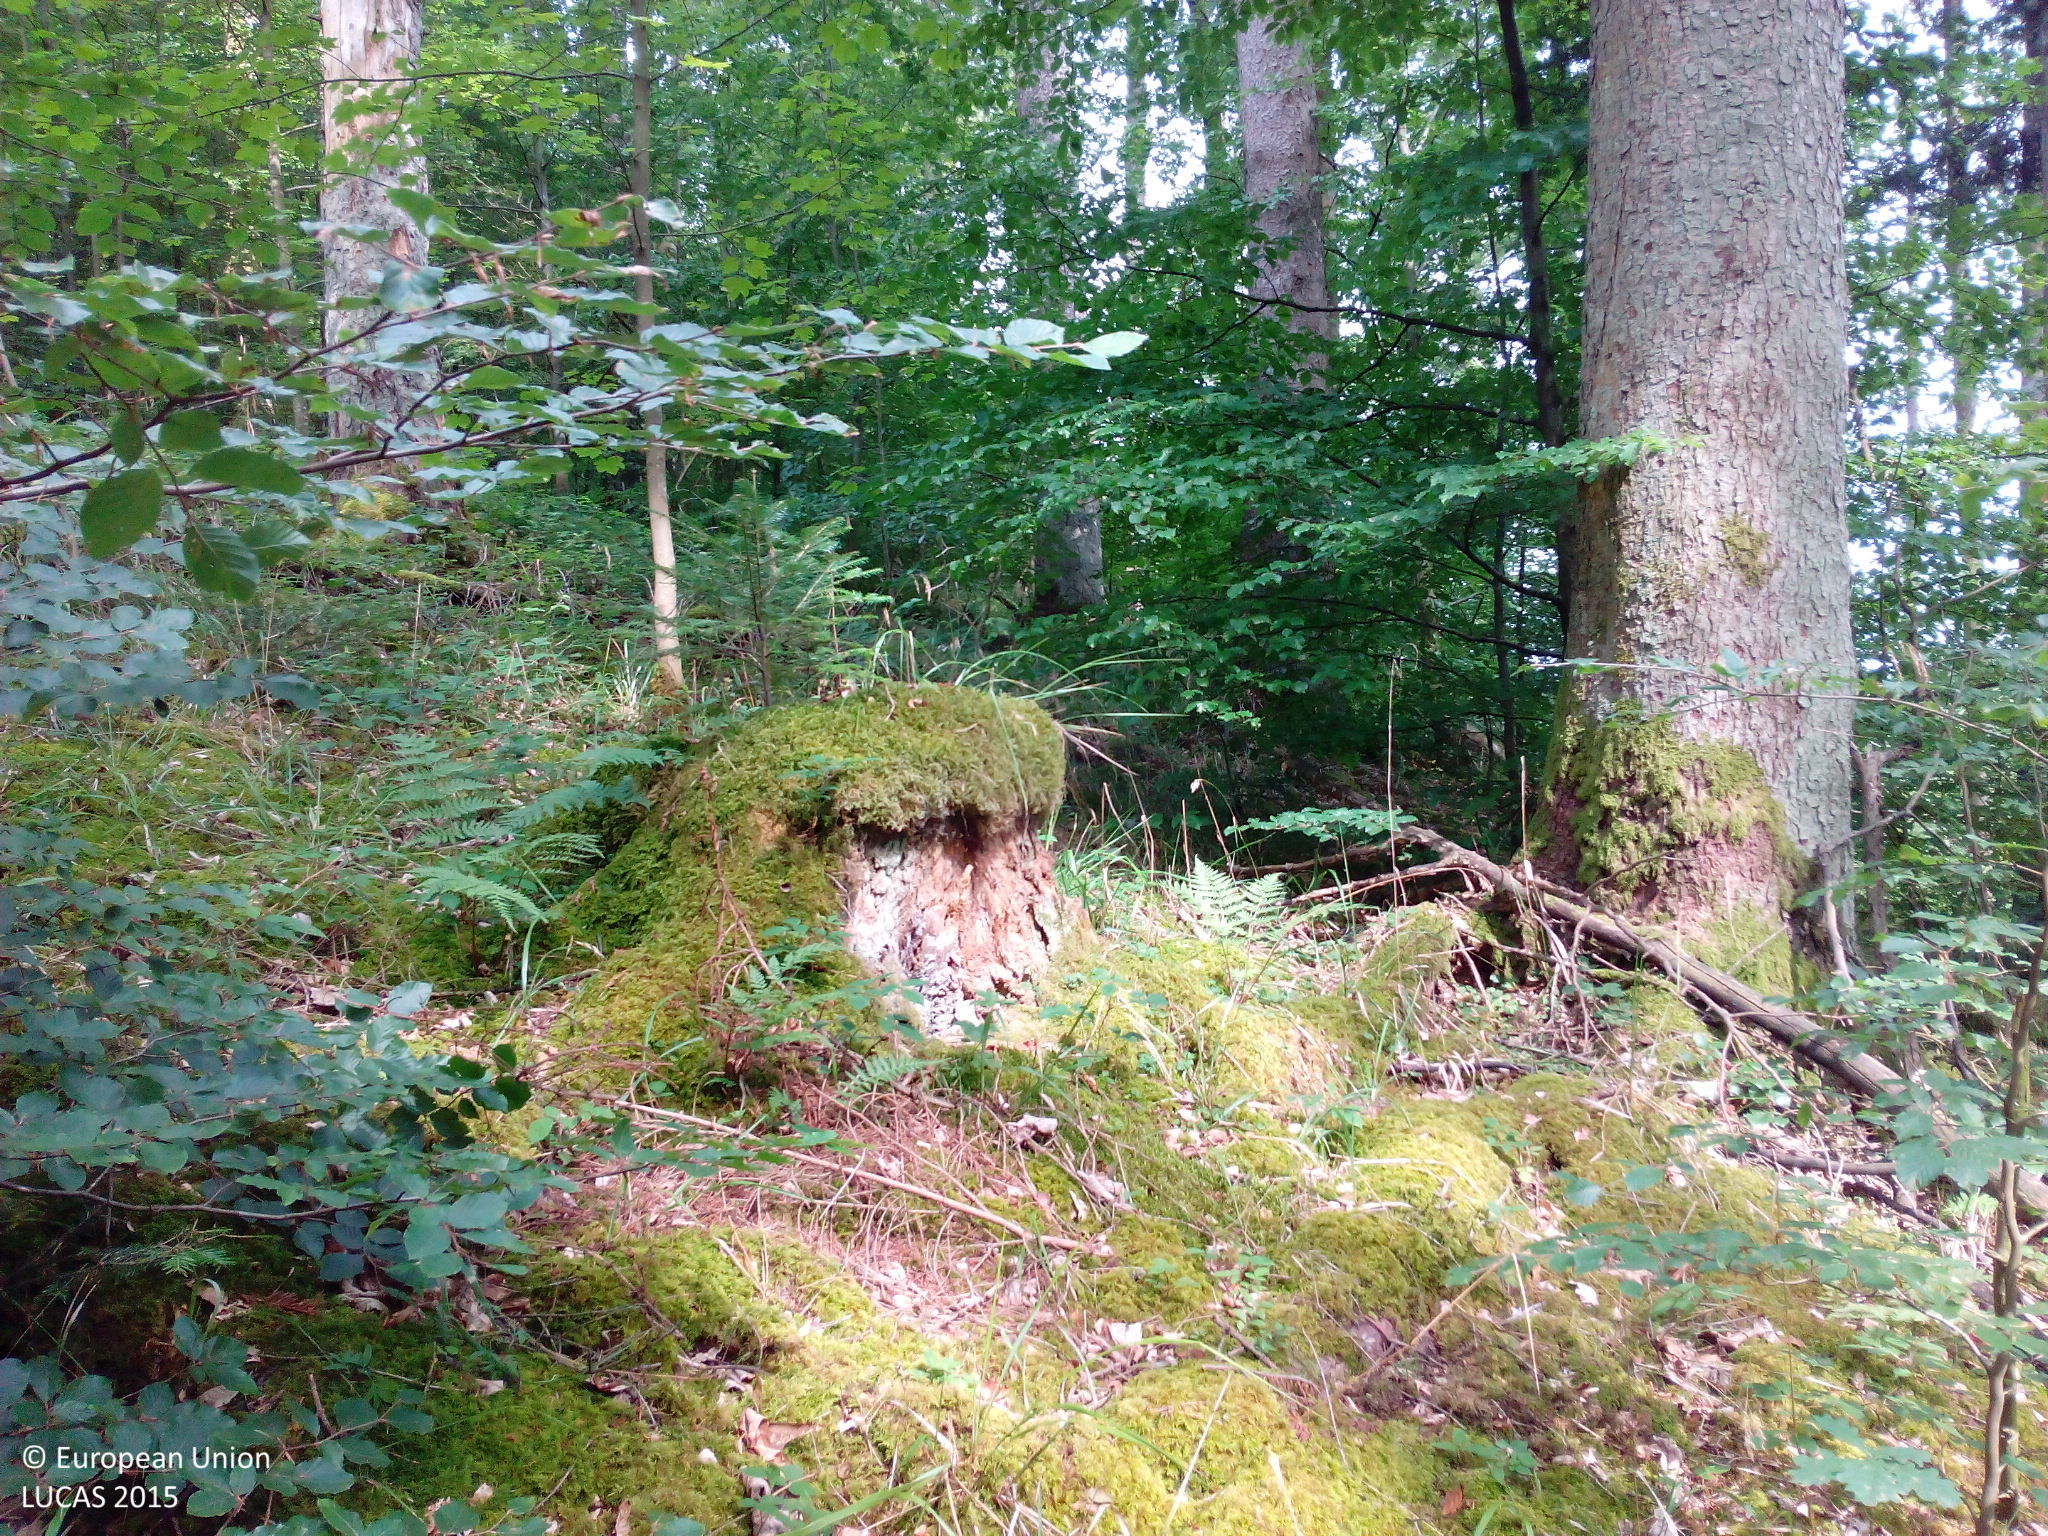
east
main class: Woodland
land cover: Other mixed woodland
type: hemiboreal forest and nemoral coniferous forest and mixed broadleaved-coniferous forest
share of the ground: > 75 %
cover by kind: coniferous forest trees 55 %, broadleaved forest trees 25 %, lichens and mosses 15 %, shrubs 5 %
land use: Forestry
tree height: > 5 m
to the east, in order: Other mixed woodland; Rivers and streams; Broadleaved woodland; Rivers and streams; Broadleaved woodland; Spruce dominated coniferous woodland
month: July
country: DE
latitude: 49.0507
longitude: 9.6854
